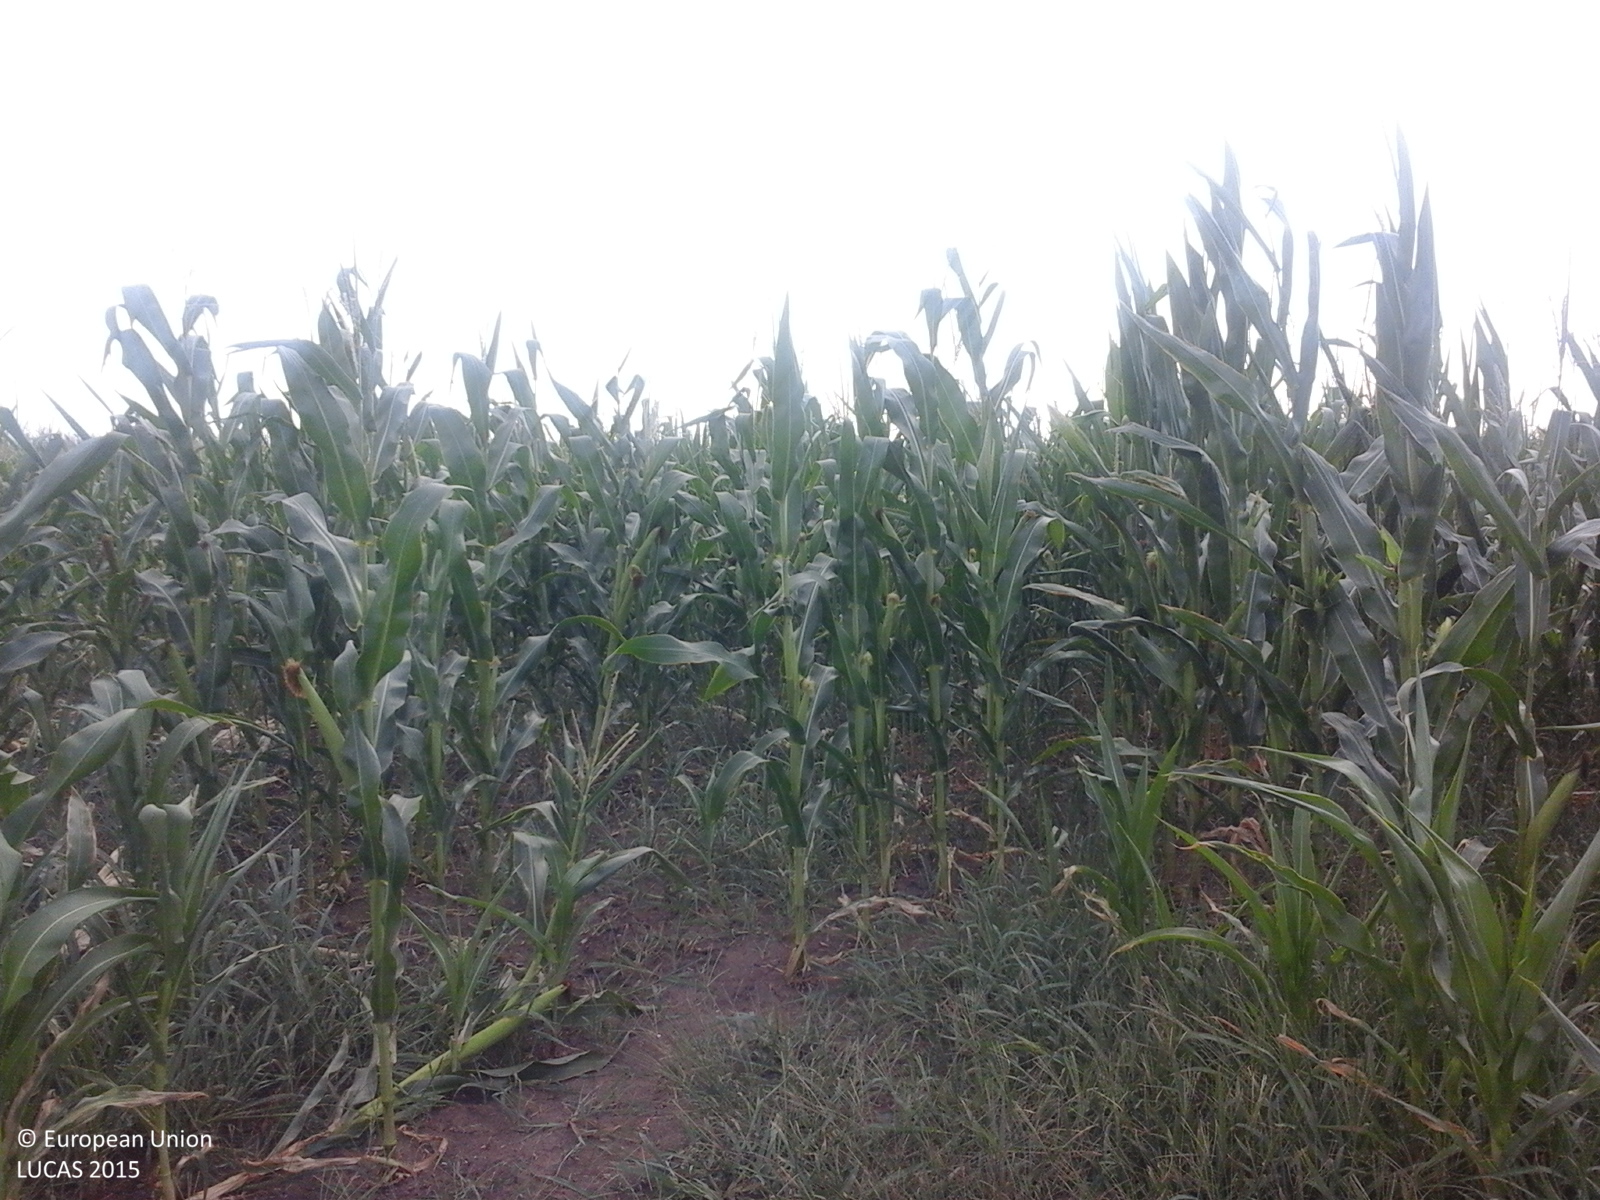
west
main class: Cropland
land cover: Maize
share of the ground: > 75 %
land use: Agriculture (excluding fallow land and kitchen gardens)
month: August
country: RO
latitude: 45.0575
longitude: 27.4035
